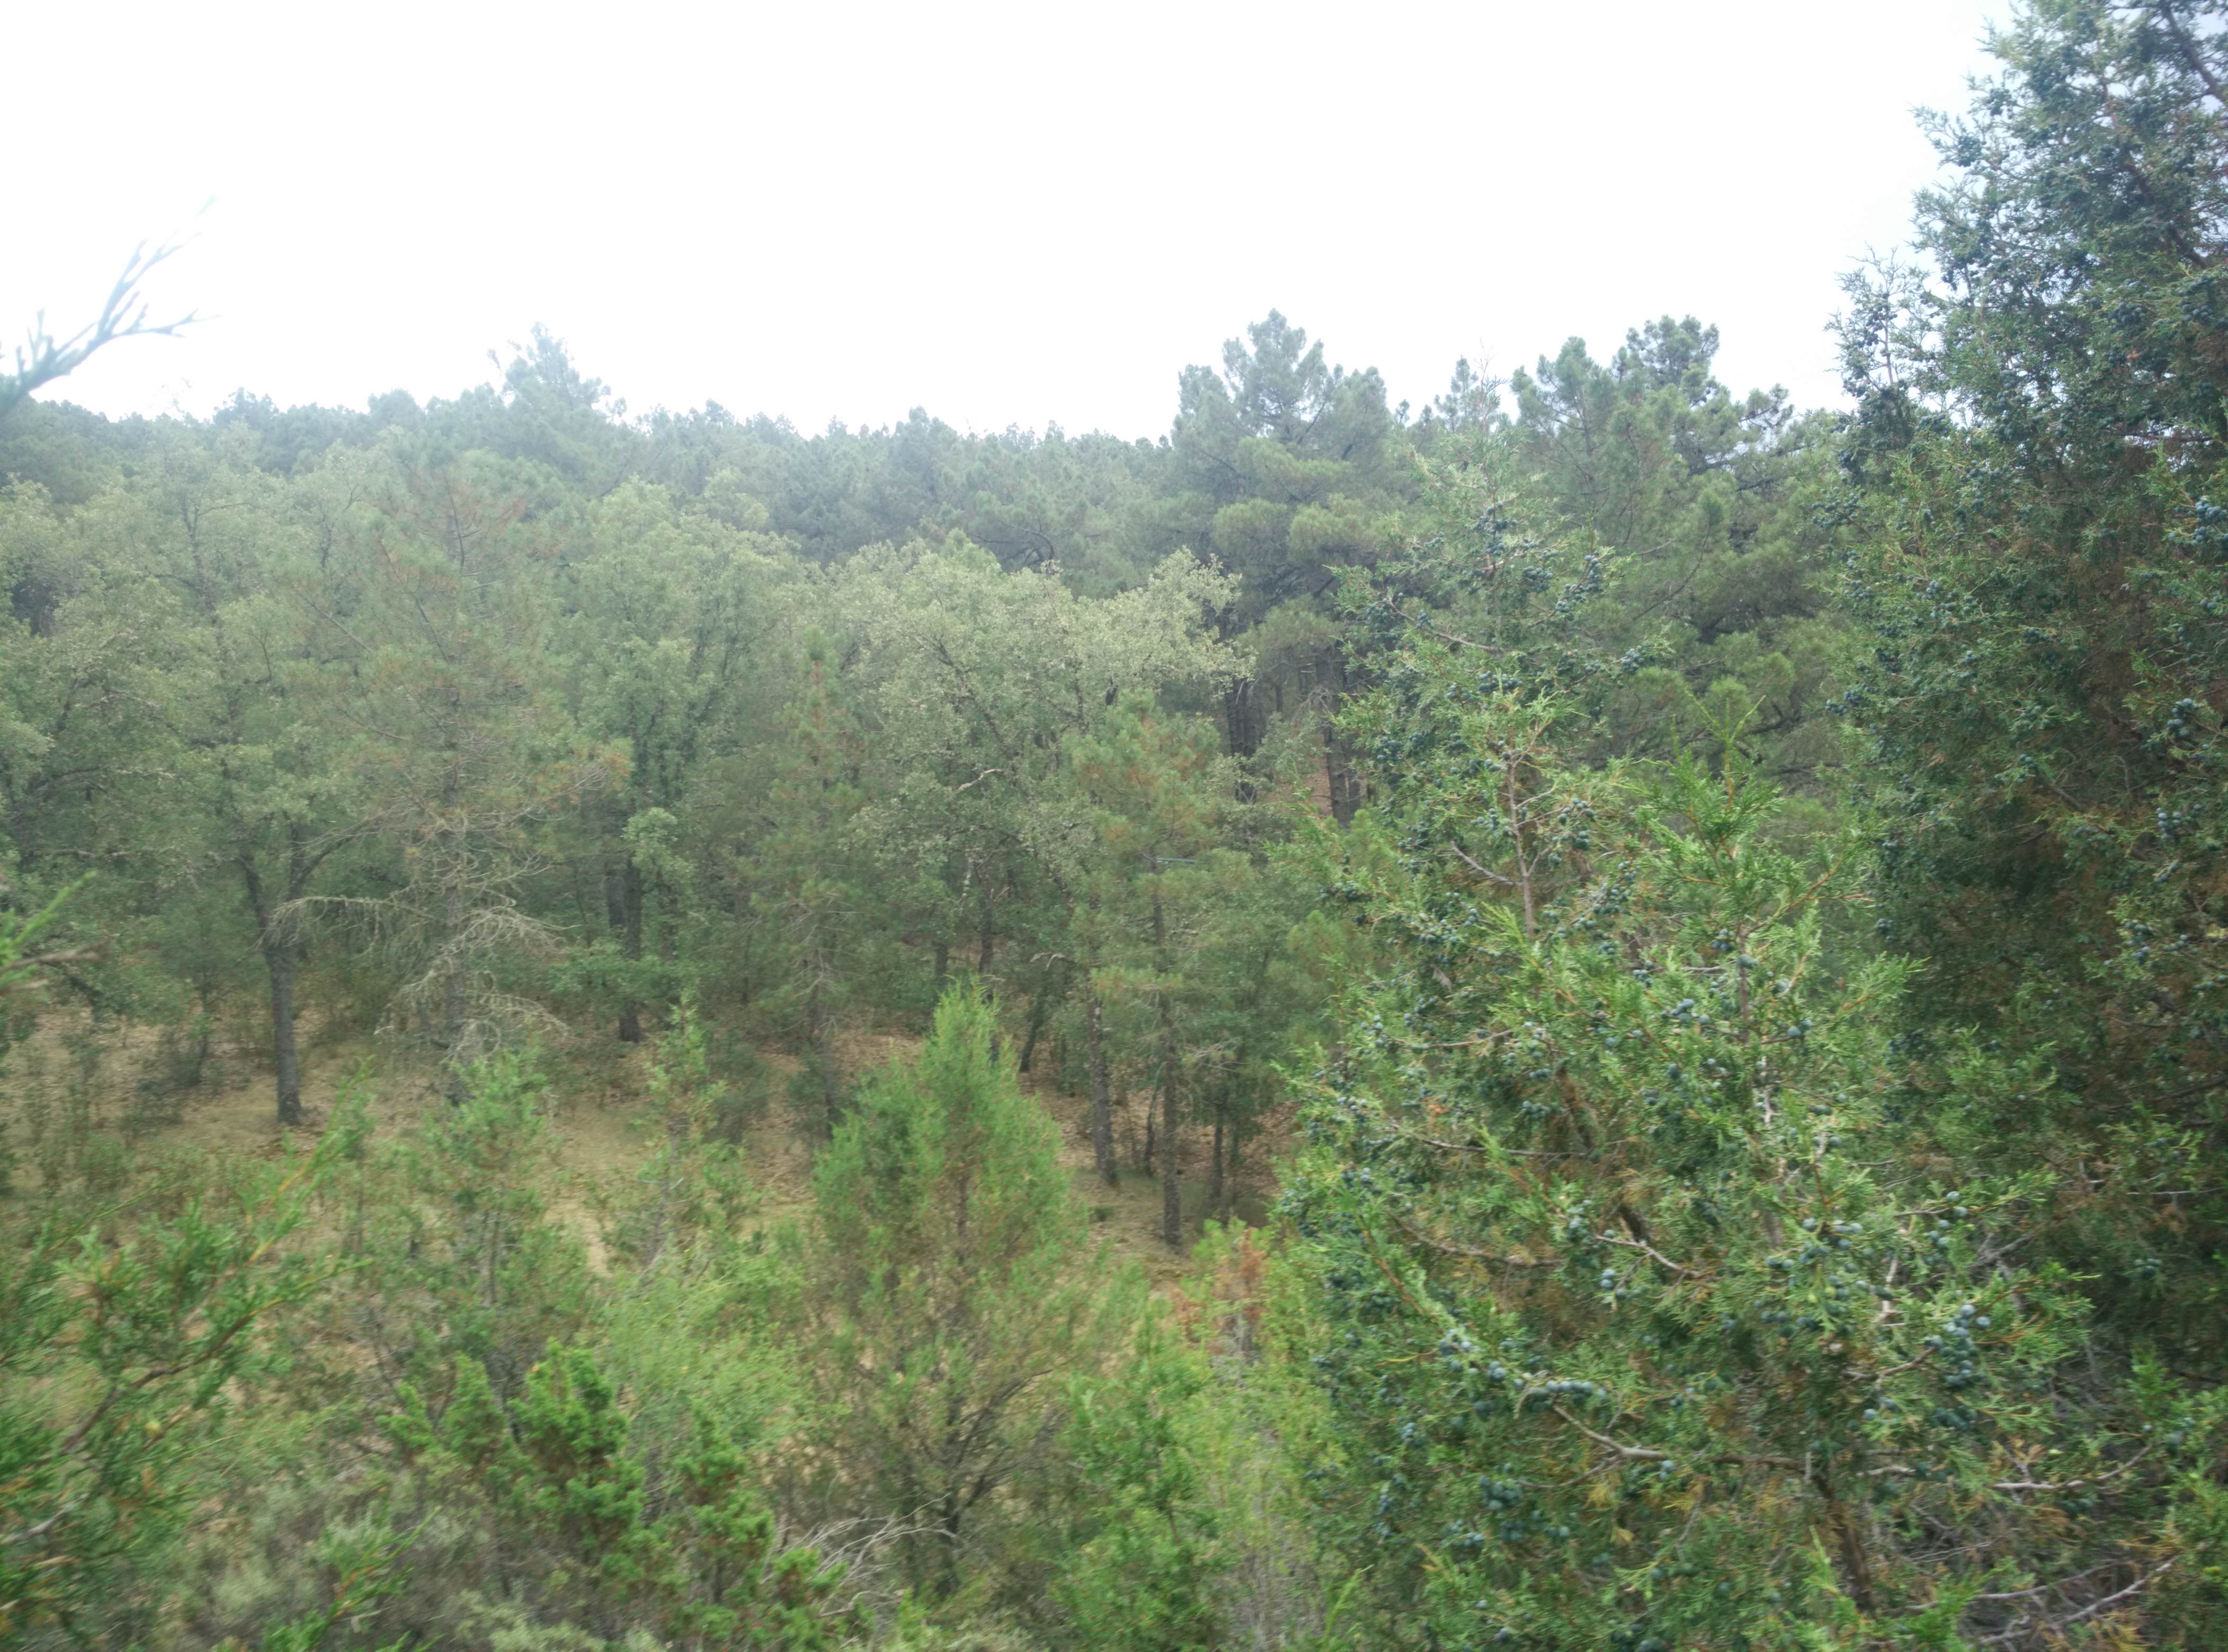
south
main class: Woodland
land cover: Other coniferous woodland
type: coniferous forest of the mediterranean region
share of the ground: 50 - 75 %
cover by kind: coniferous forest trees 40 %, consolidated bare surface 30 %, shrubs 25 %, broadleaved forest trees 5 %
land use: Semi-natural and natural areas not in use
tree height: > 5 m
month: July
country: ES
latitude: 40.8891
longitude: -2.0711
